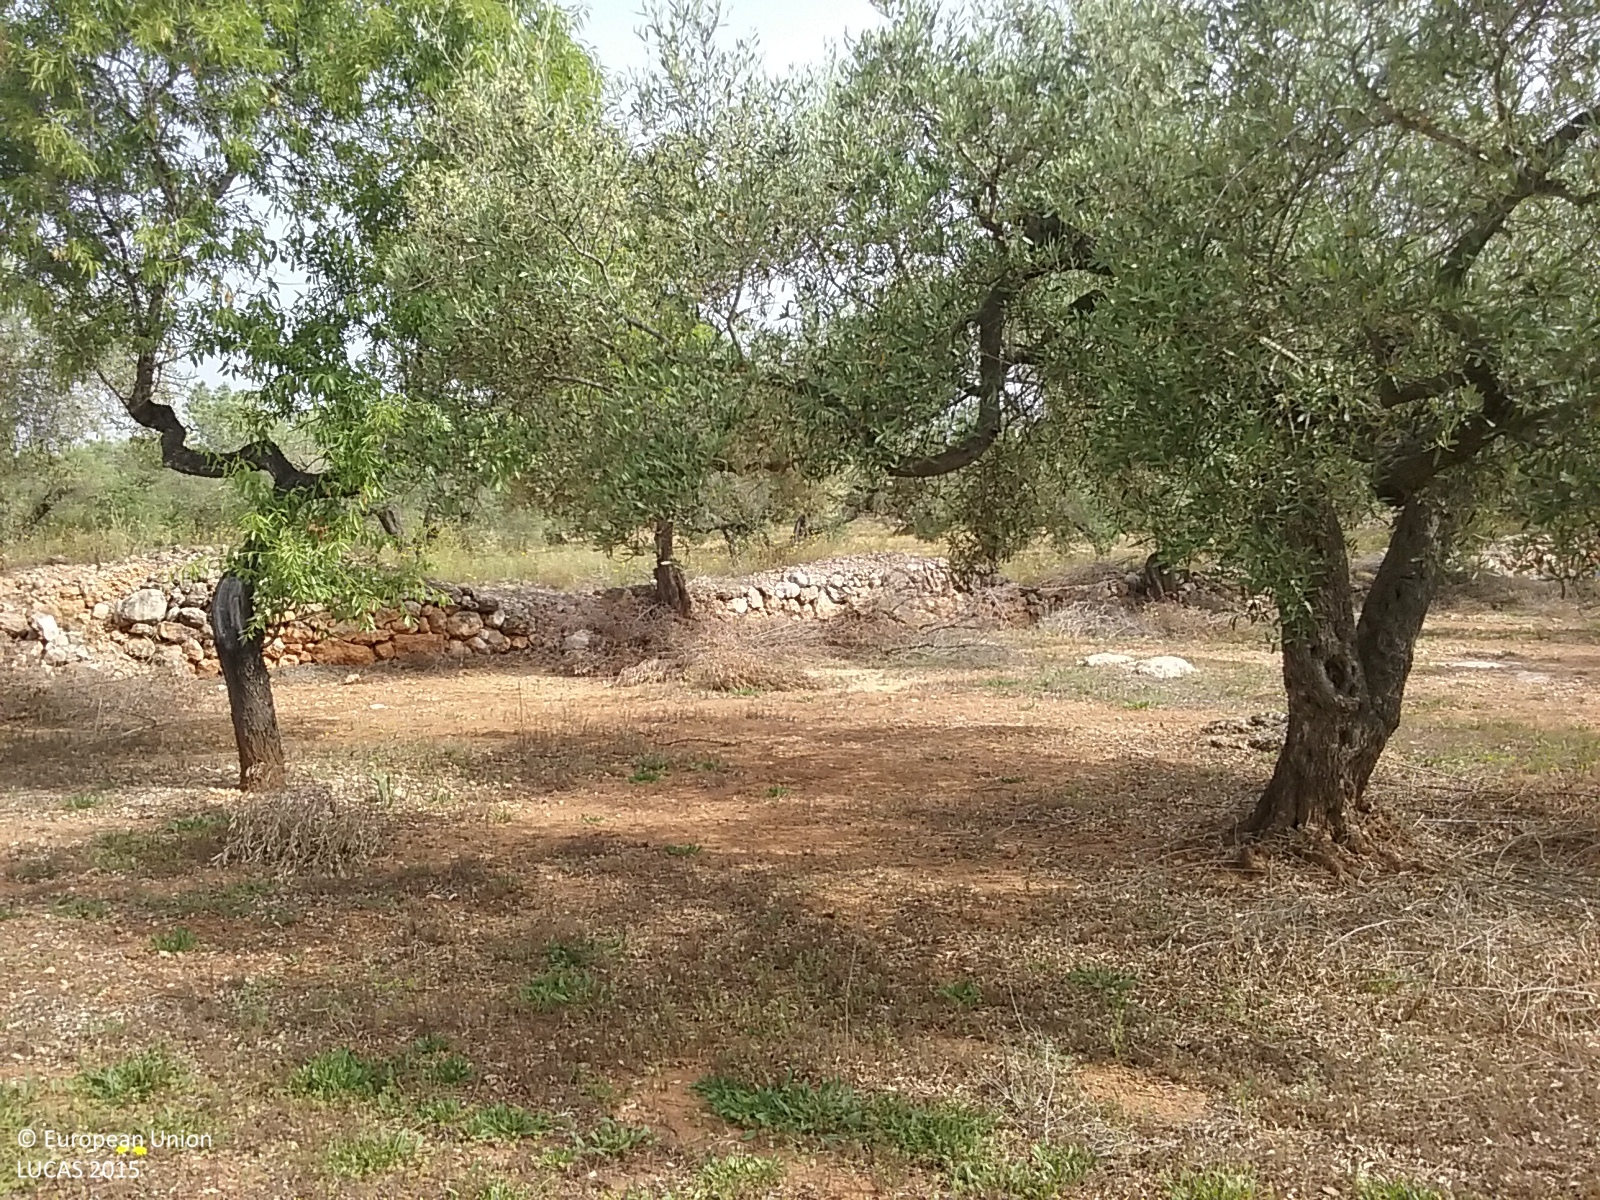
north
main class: Cropland
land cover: Olive groves
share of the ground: 25 - 50 %
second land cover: Spontaneously vegetated surfaces
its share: 25 - 50 %
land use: Agriculture (excluding fallow land and kitchen gardens)
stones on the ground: 25 - 50 %
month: May
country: ES
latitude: 40.7638
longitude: 0.6242
